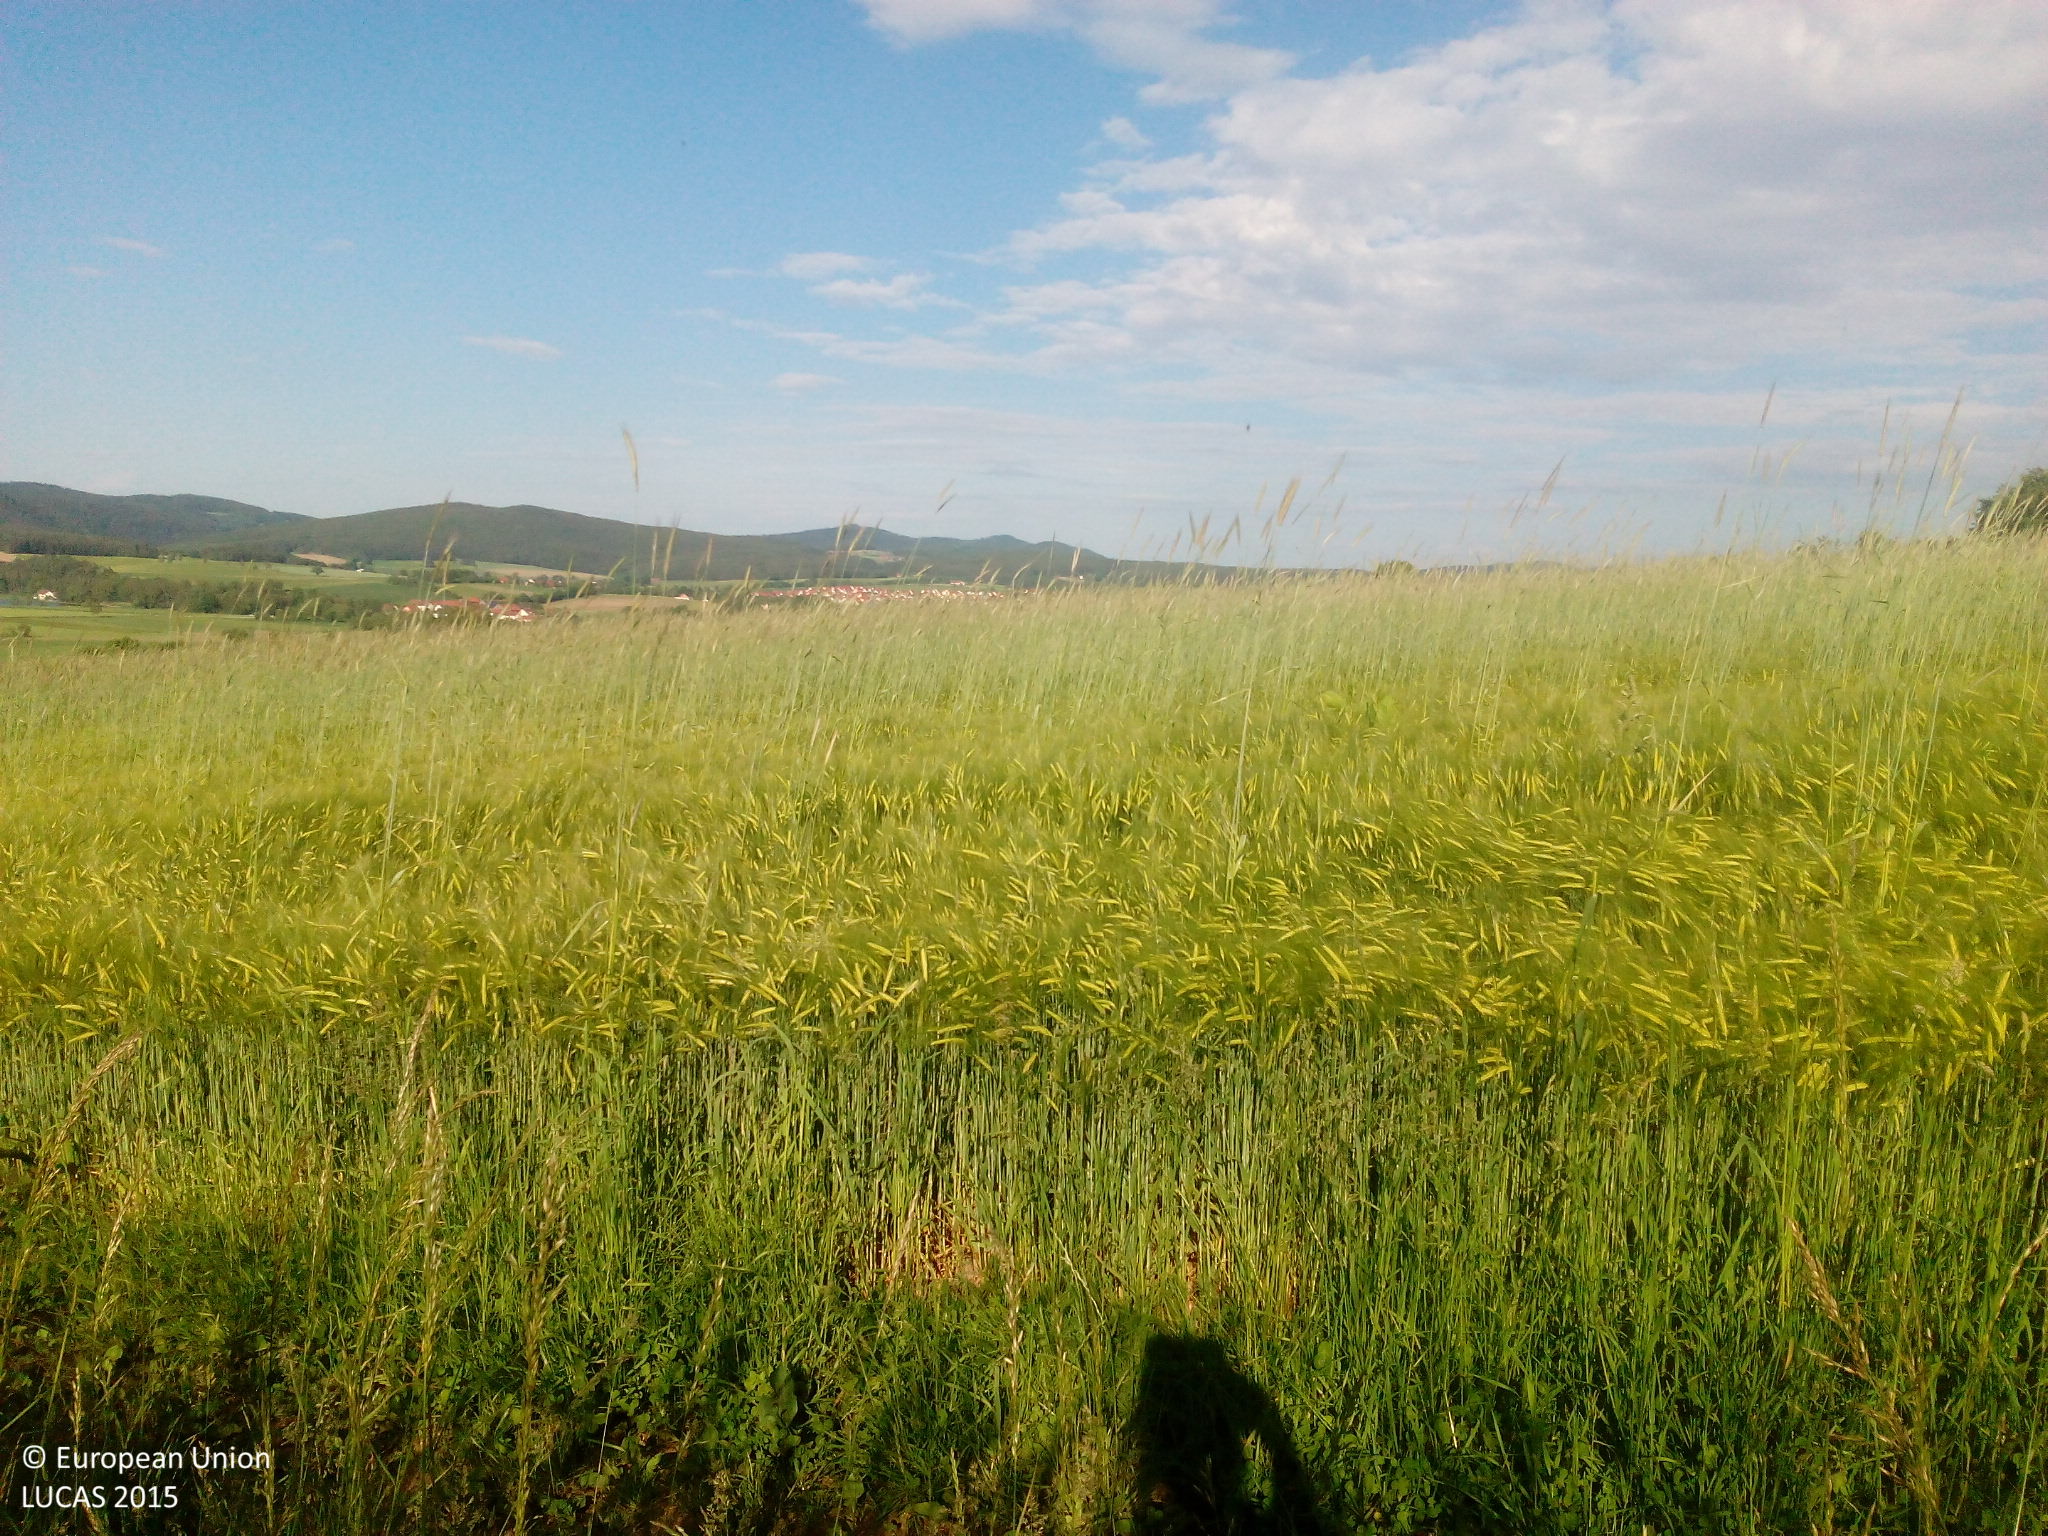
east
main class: Cropland
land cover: Rye
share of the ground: > 75 %
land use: Agriculture (excluding fallow land and kitchen gardens)
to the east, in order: Rye; Grass margins; Tracks; Grass margins; Barley; Grass margins; Barley; Broadleaved woodland; Grassland without tree/shrub cover; Abandoned hedges; Tracks; Grass margins; Triticale
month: June
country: DE
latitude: 49.3503
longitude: 12.3535
